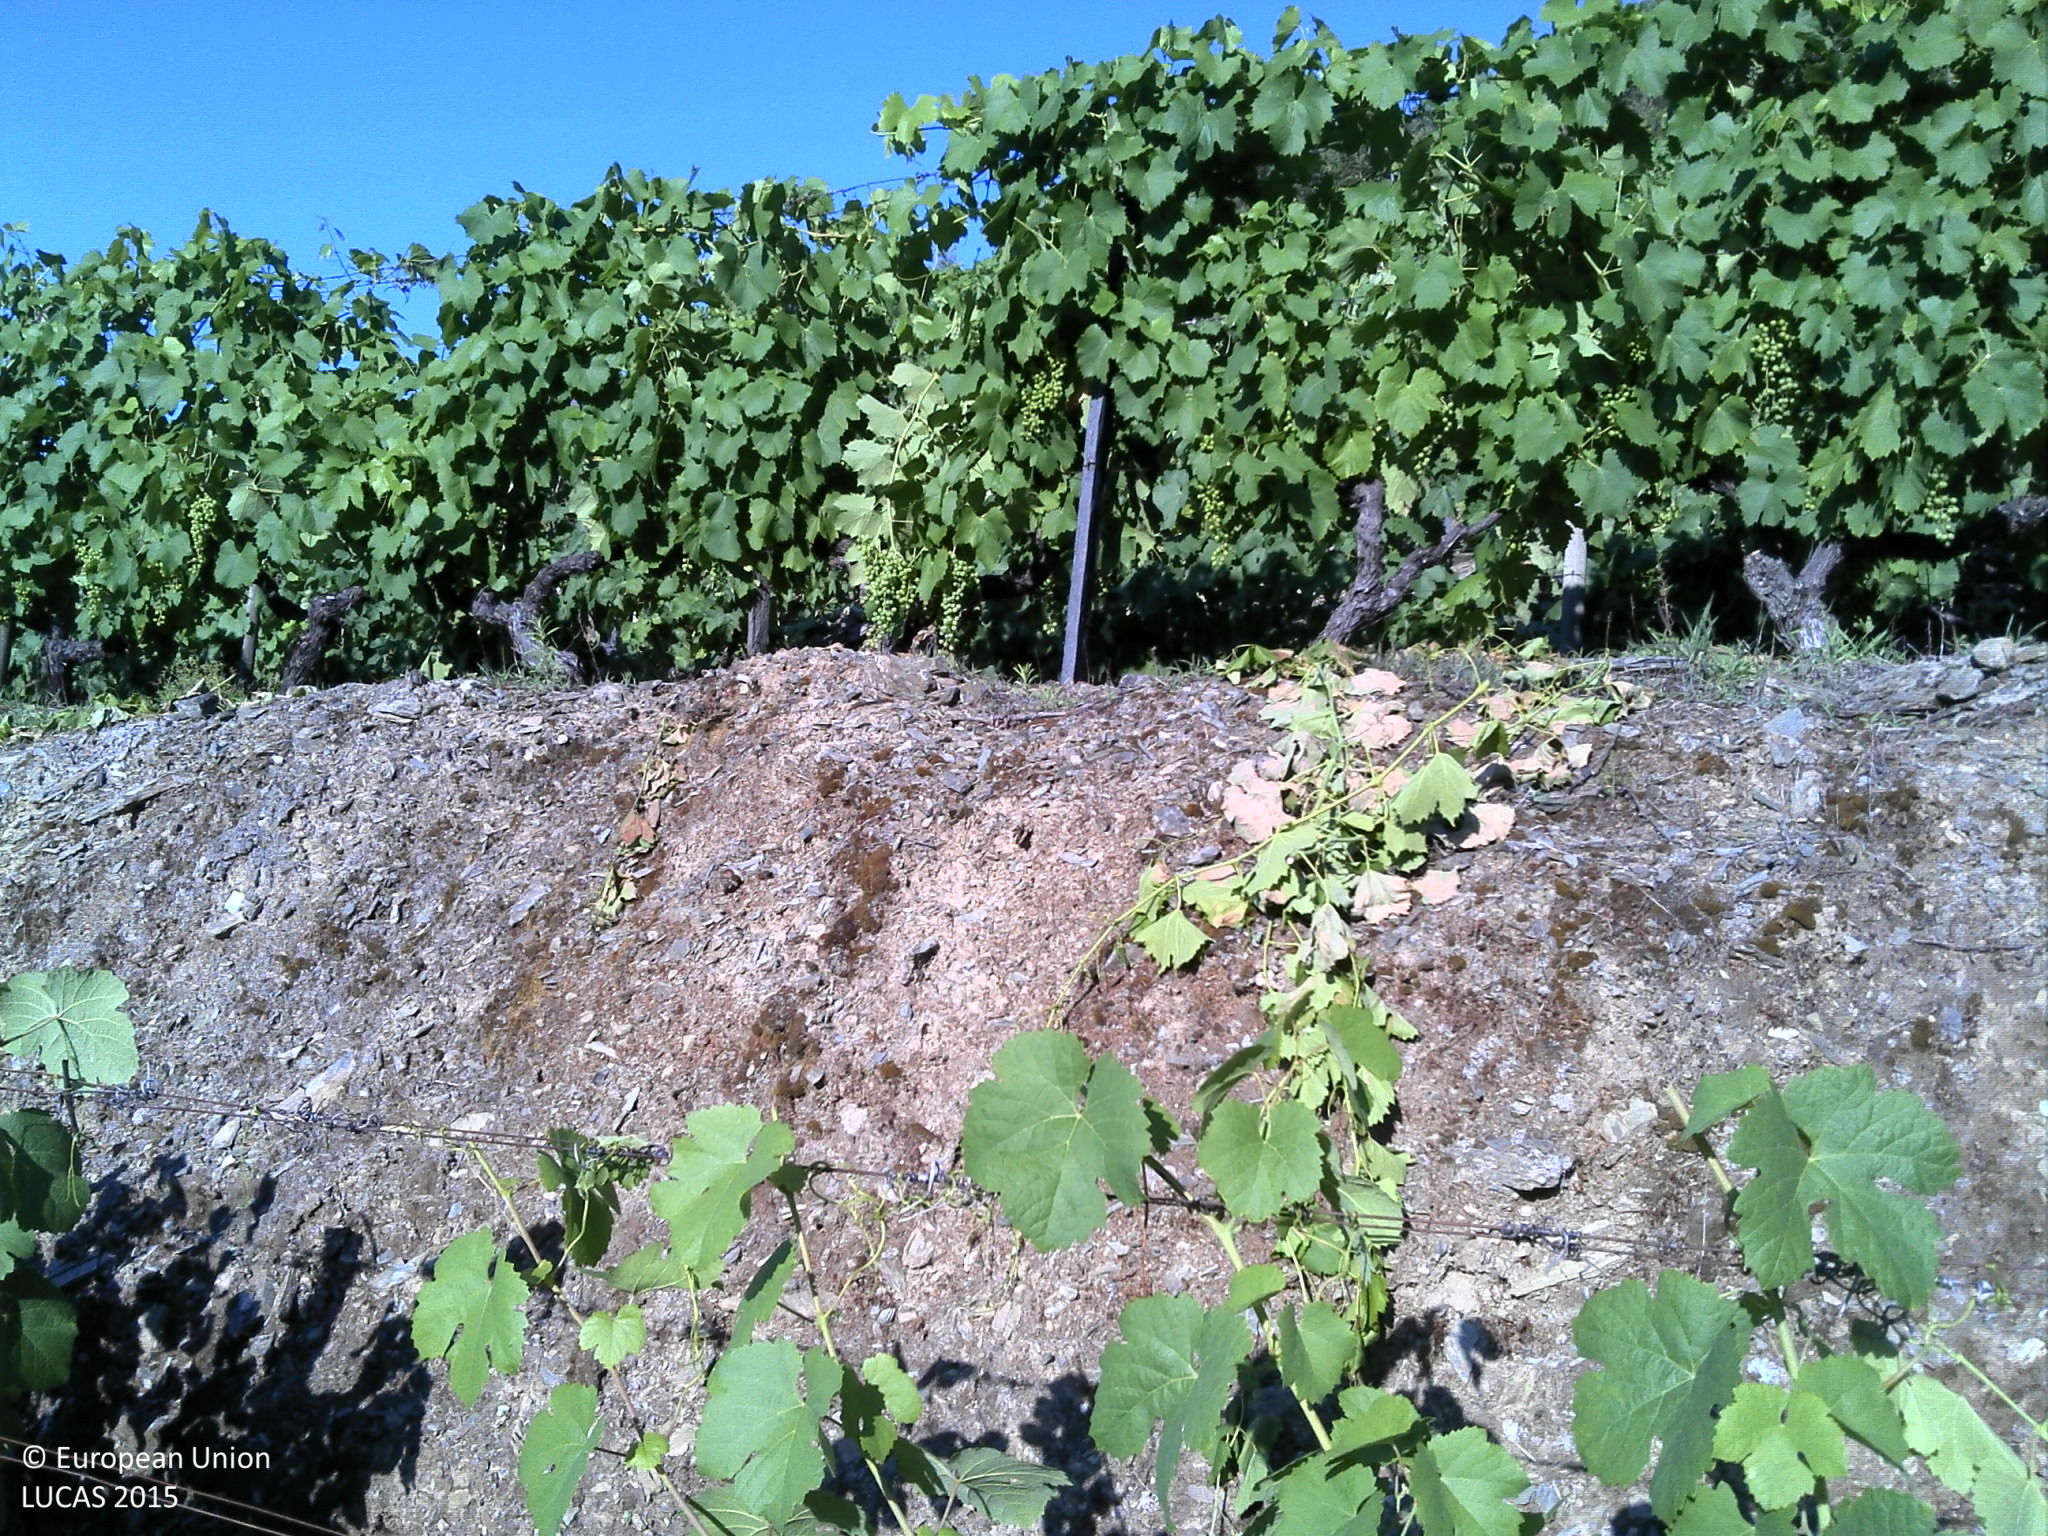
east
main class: Cropland
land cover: Vineyards
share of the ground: 10 - 25 %
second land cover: Grassland without tree/shrub cover
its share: 25 - 50 %
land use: Agriculture (excluding fallow land and kitchen gardens)
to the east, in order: Vineyards; Grassland without tree/shrub cover; Vineyards; Tracks; Vineyards; Tracks; Broadleaved woodland; Dry stone walls; Broadleaved woodland; Dry stone walls; Broadleaved woodland; Dry stone walls; Broadleaved woodland; Vineyards; Dry stone walls; Vineyards; Dry stone walls; Other bare soil; Tracks; Broadleaved woodland
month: June
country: PT
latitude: 41.1529
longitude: -7.6053
